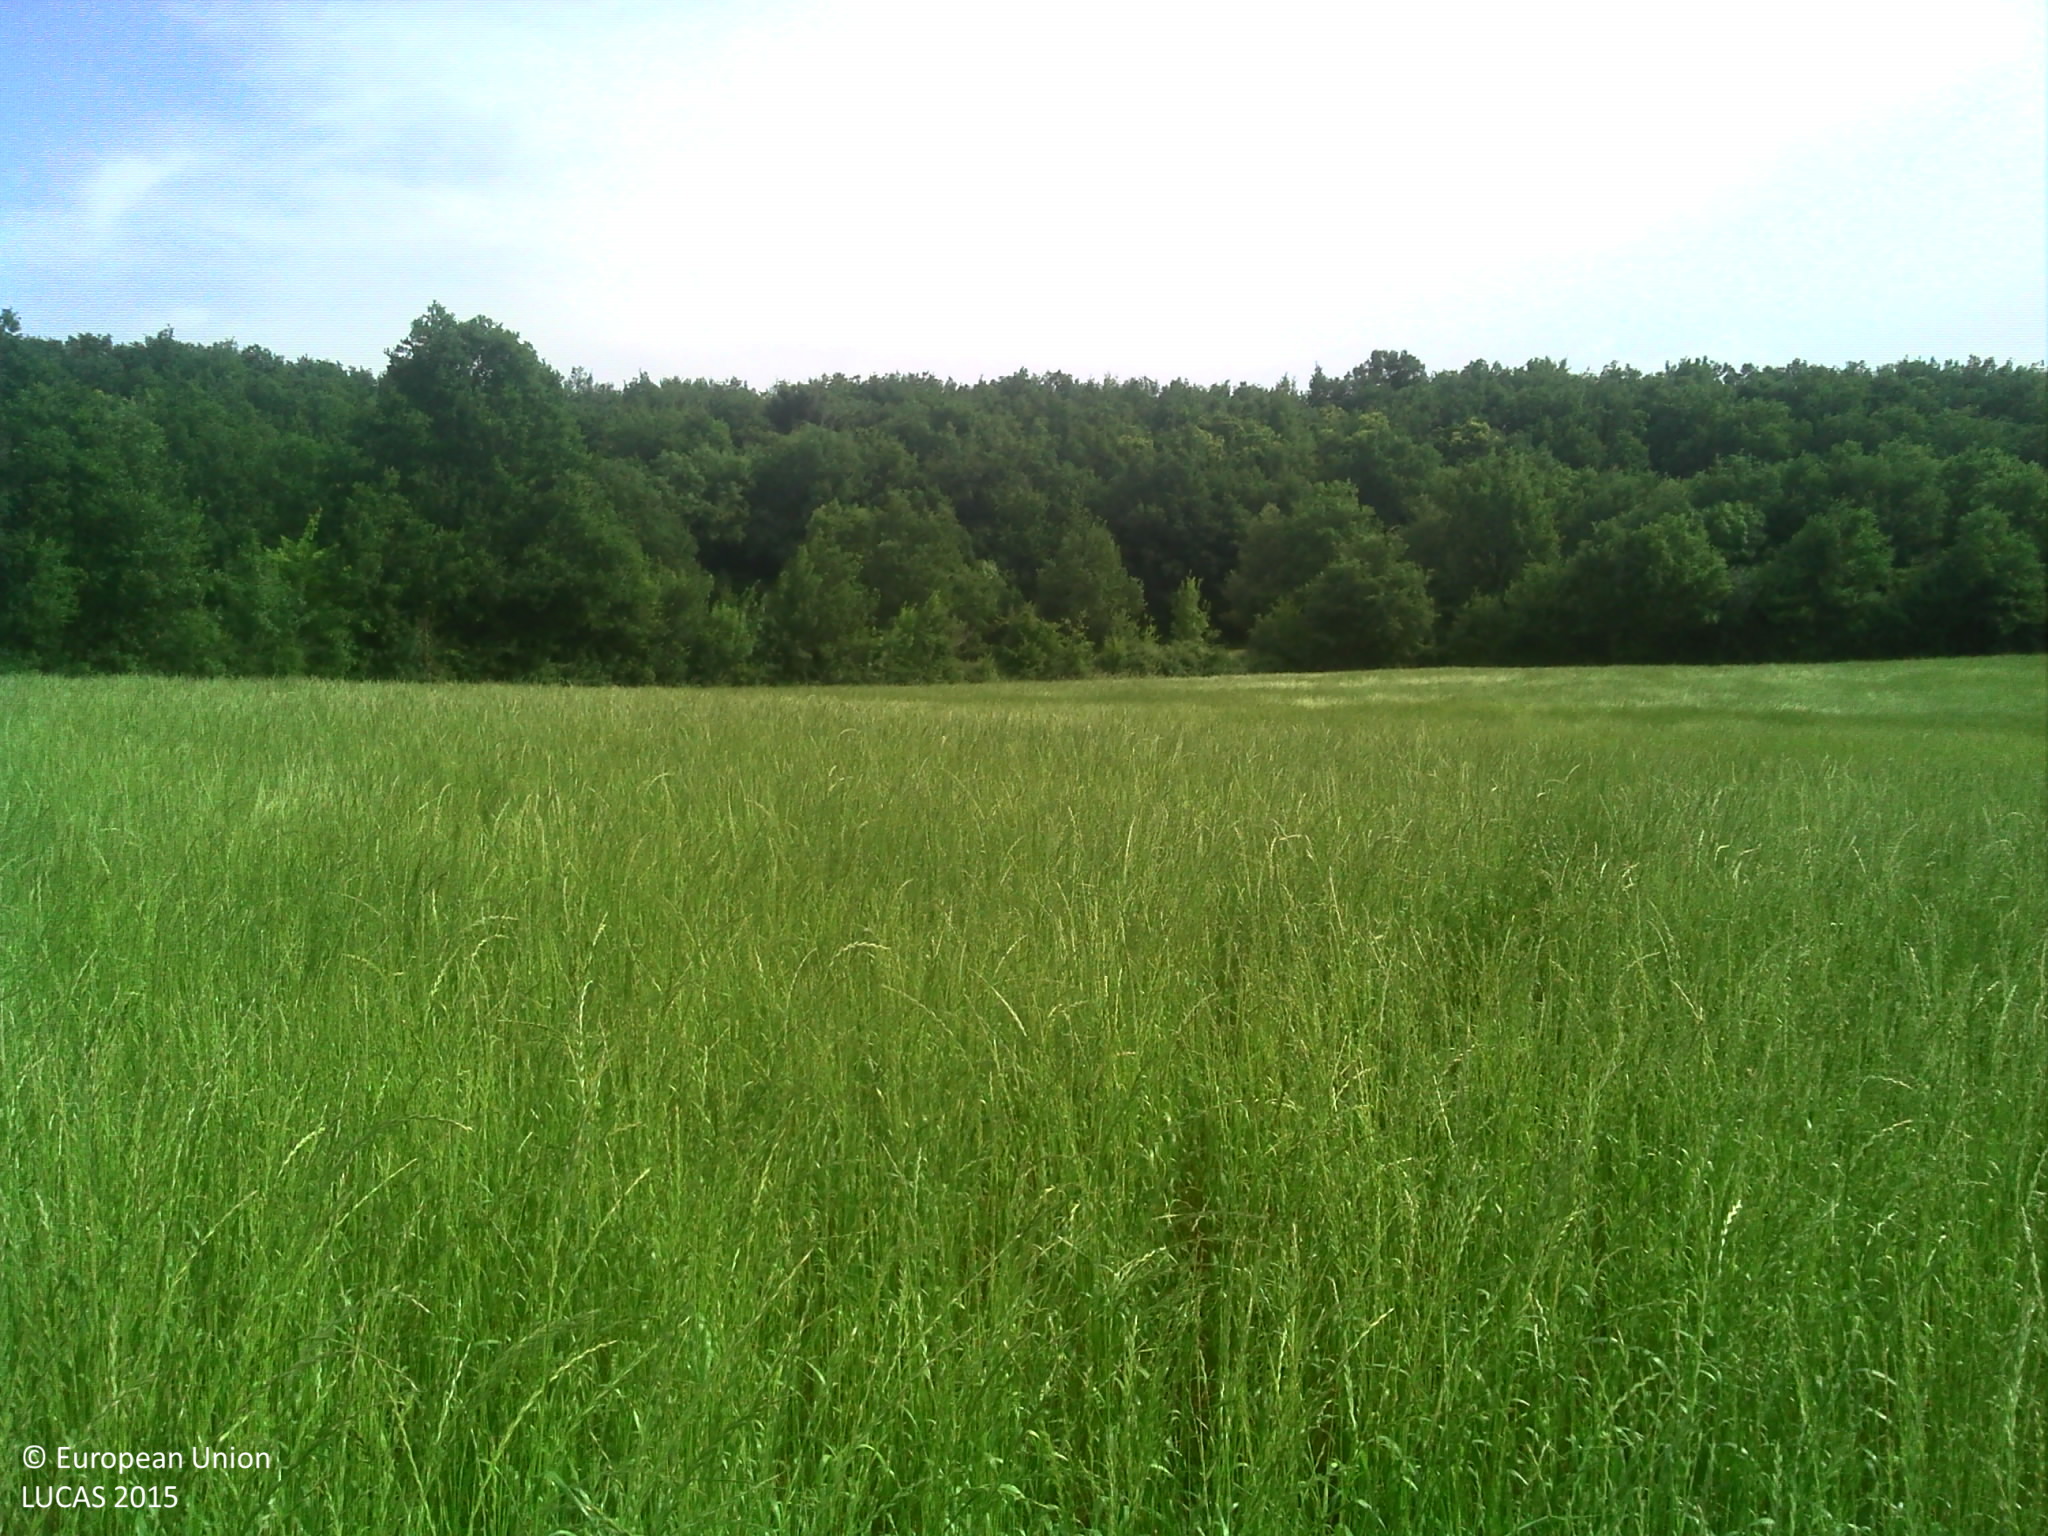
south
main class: Cropland
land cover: Temporary grasslands
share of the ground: > 75 %
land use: Agriculture (excluding fallow land and kitchen gardens)
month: June
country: FR
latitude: 43.6952
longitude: 1.9767
